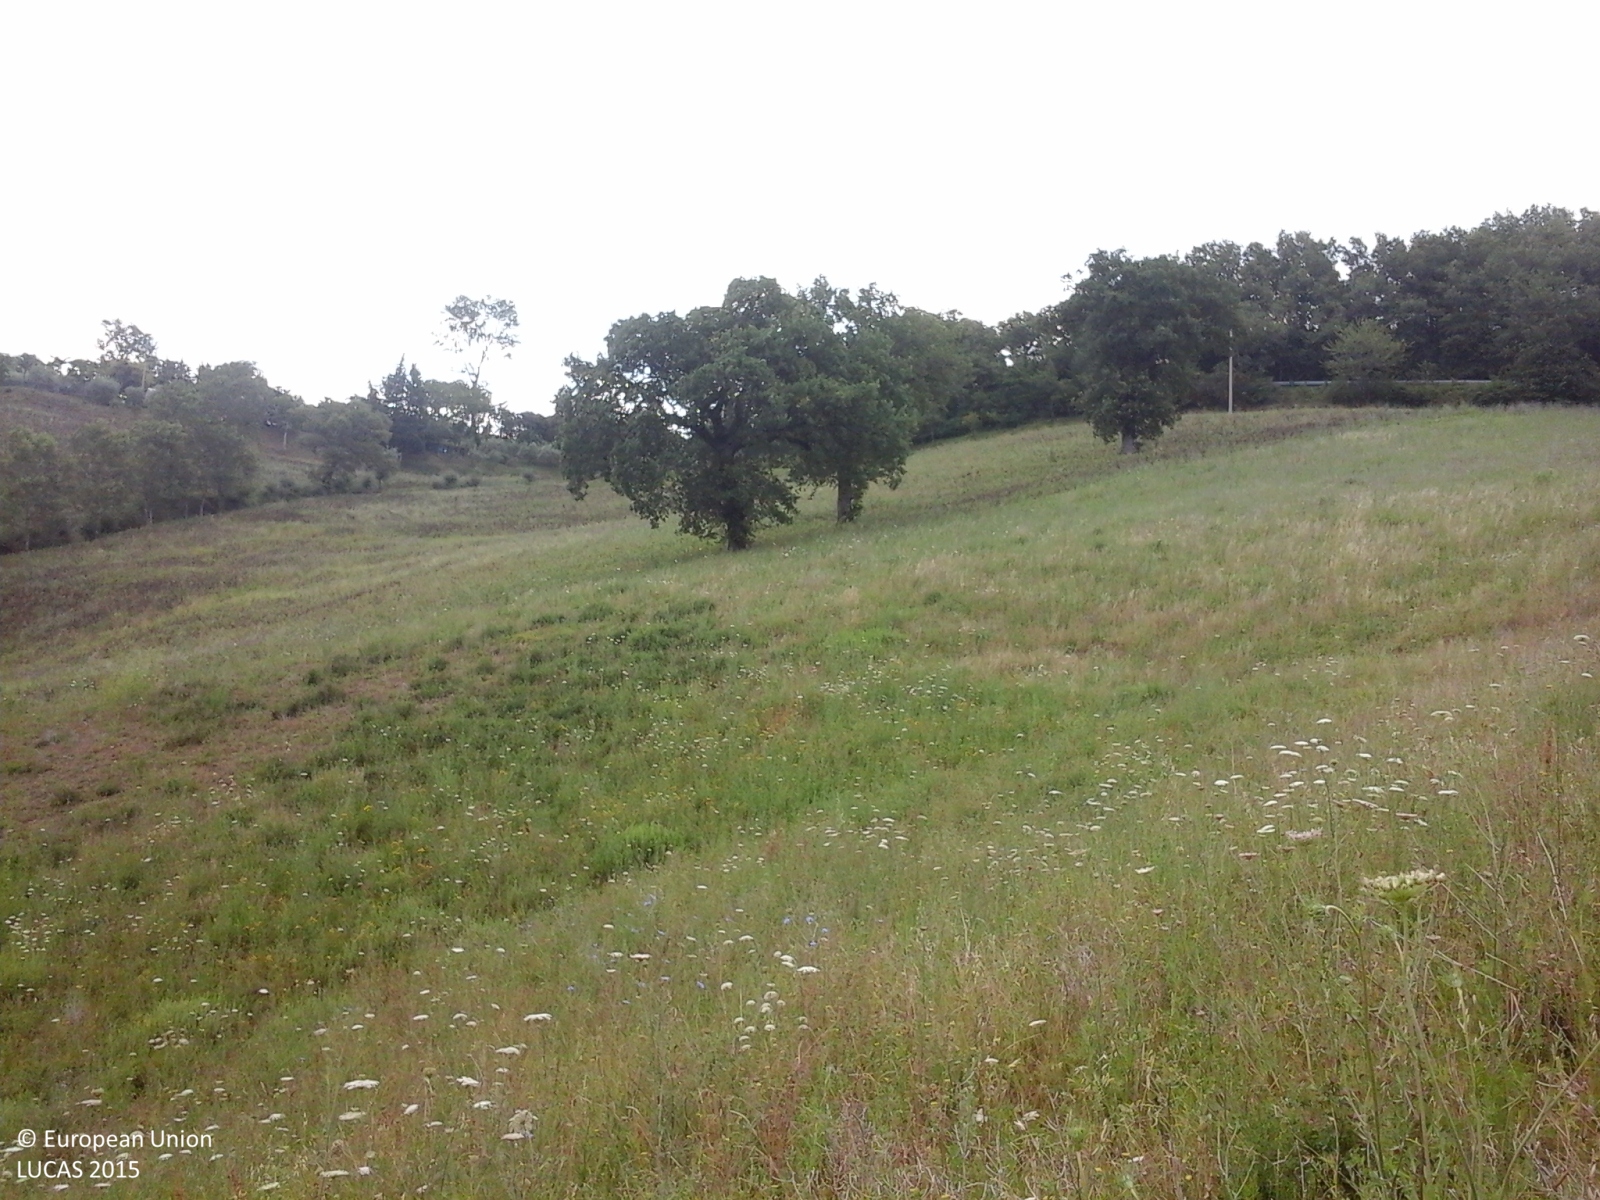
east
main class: Grassland
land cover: Spontaneously vegetated surfaces
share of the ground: > 75 %
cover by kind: herbaceous plants 95 %, shrubs 5 %
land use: Agriculture (excluding fallow land and kitchen gardens)
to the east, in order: Spontaneously vegetated surfaces; Broadleaved woodland; Other leguminous and mixtures for fodder; Electric lines; Other leguminous and mixtures for fodder; Broadleaved woodland; Paved roads, cycling and walking lanes; Broadleaved woodland; Barley
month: June
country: IT
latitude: 43.1997
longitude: 13.2034
